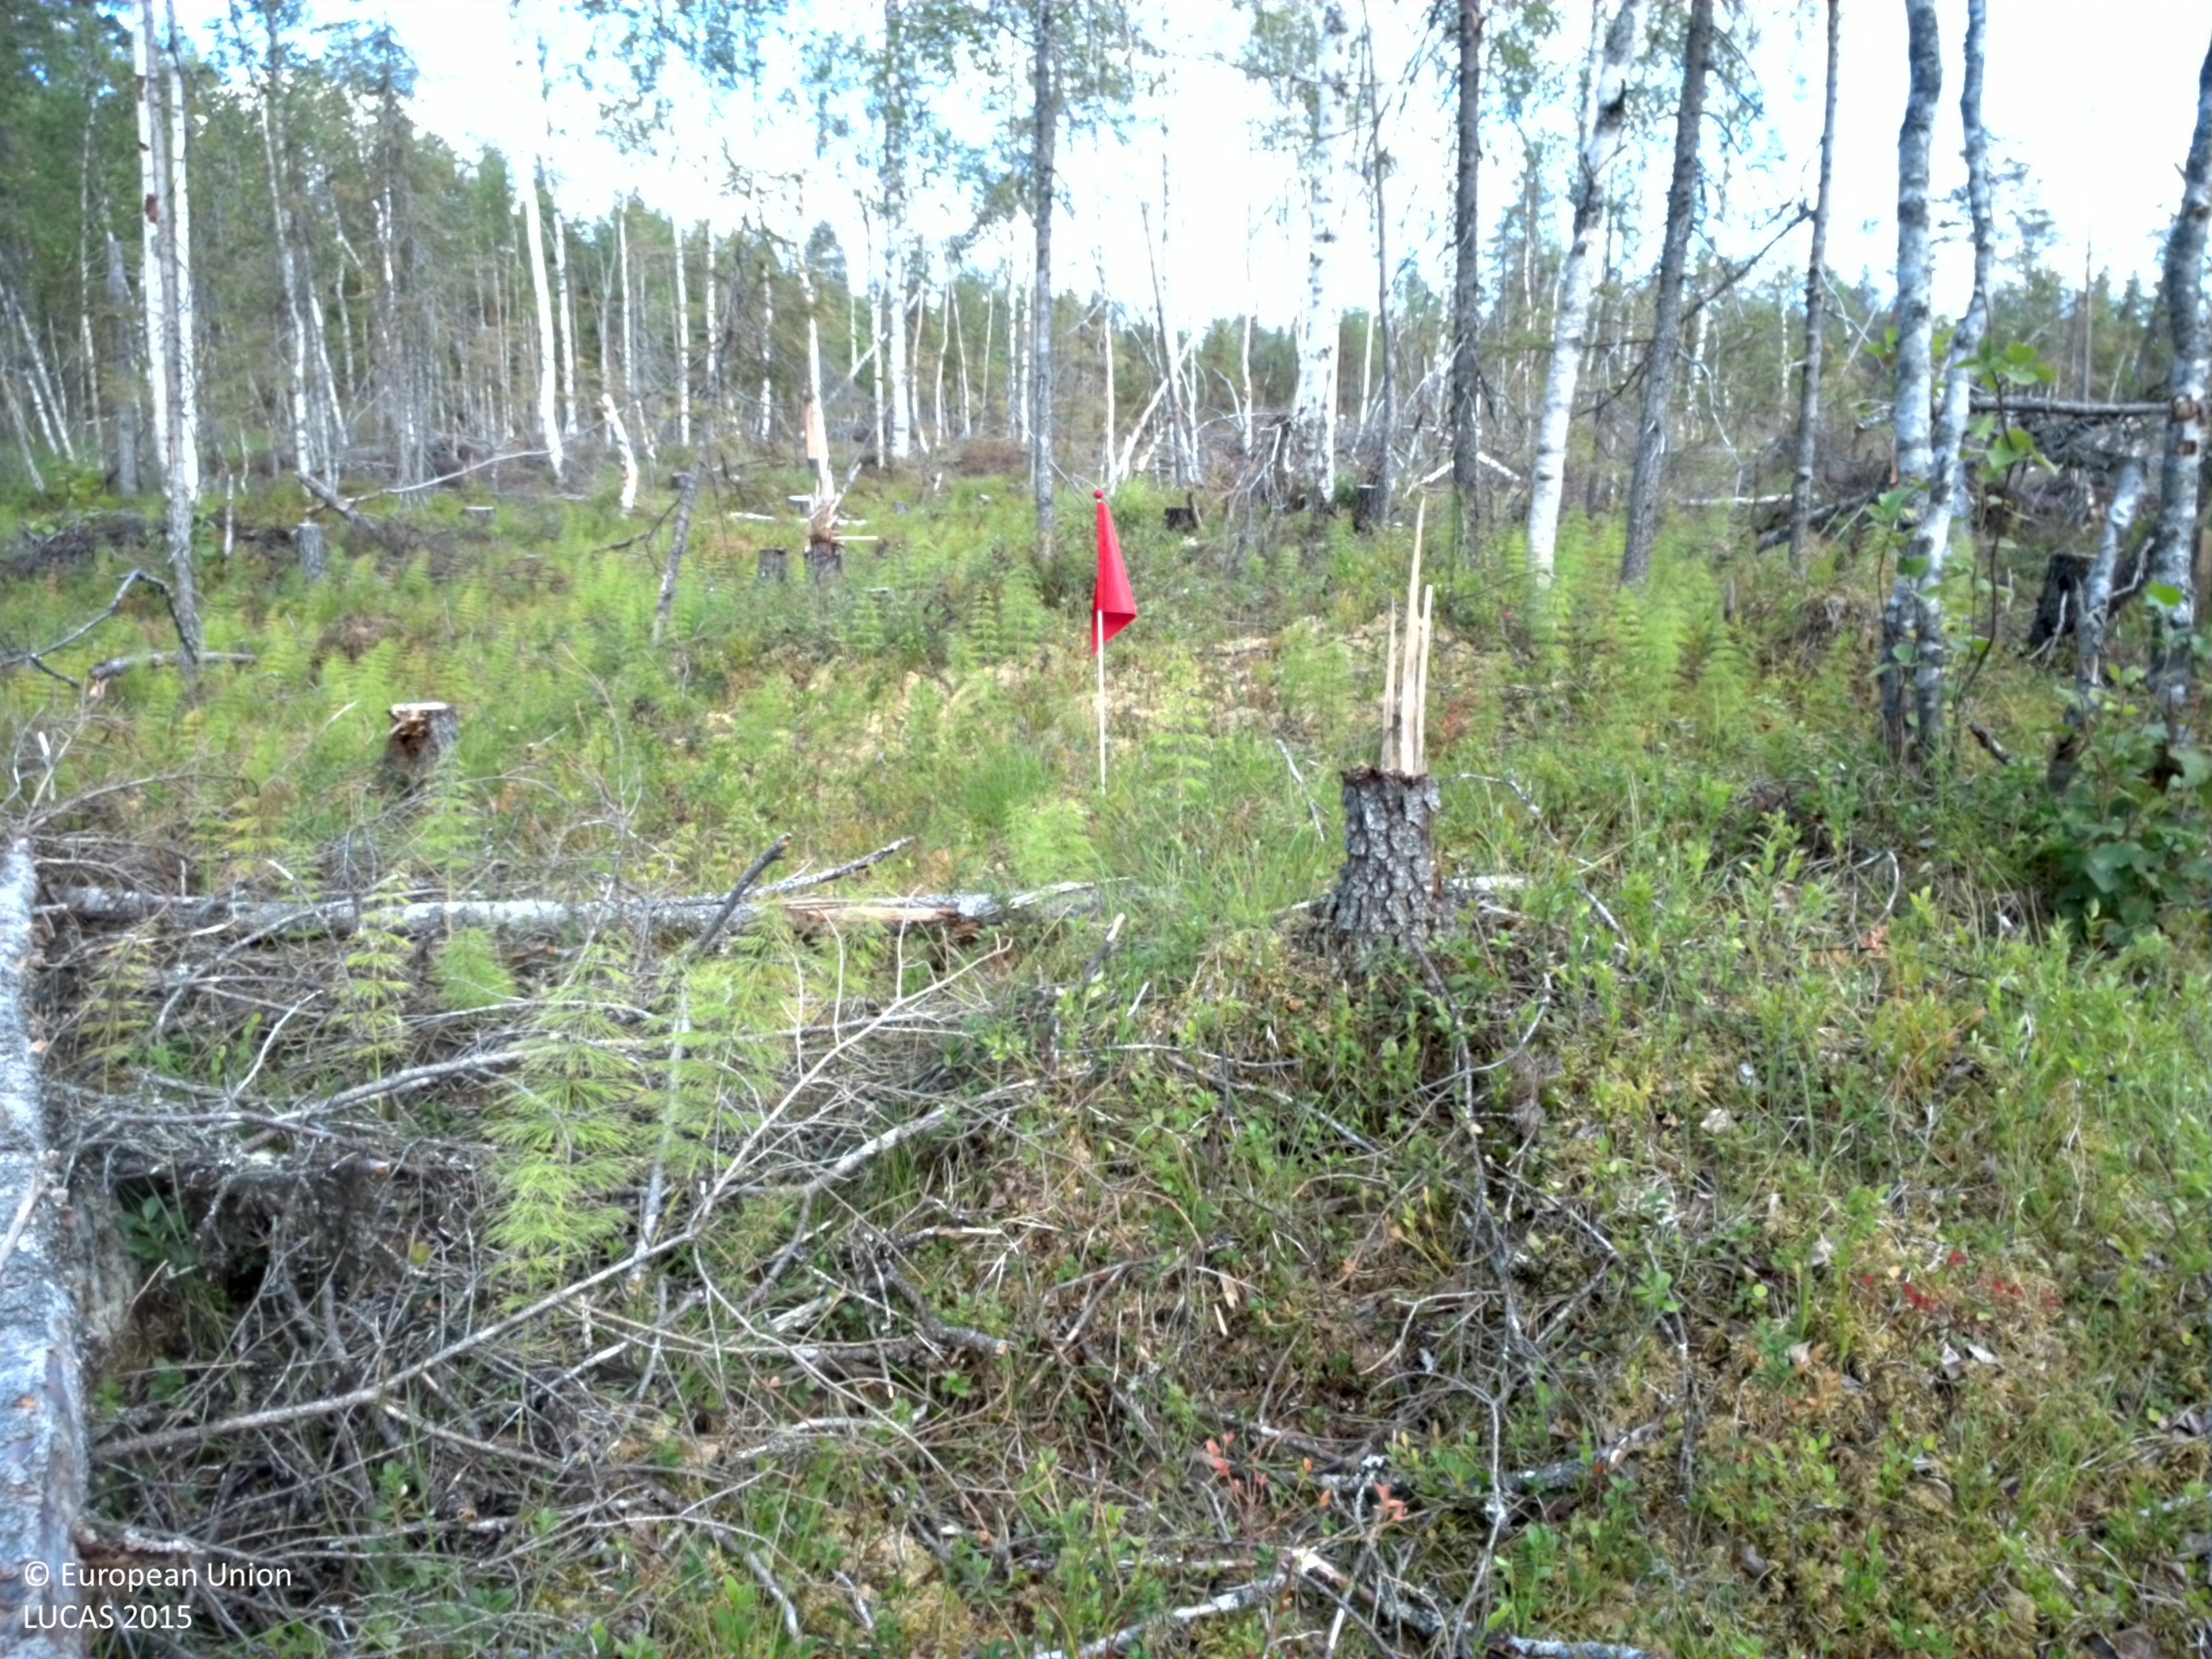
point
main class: Woodland
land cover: Broadleaved woodland
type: boreal forest
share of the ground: 10 - 25 %
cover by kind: shrubs 65 %, broadleaved forest trees 20 %, lichens and mosses 10 %, coniferous forest trees 5 %
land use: Forestry
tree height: > 5 m
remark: Clear cut
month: August
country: SE
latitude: 66.2376
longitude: 22.6764
